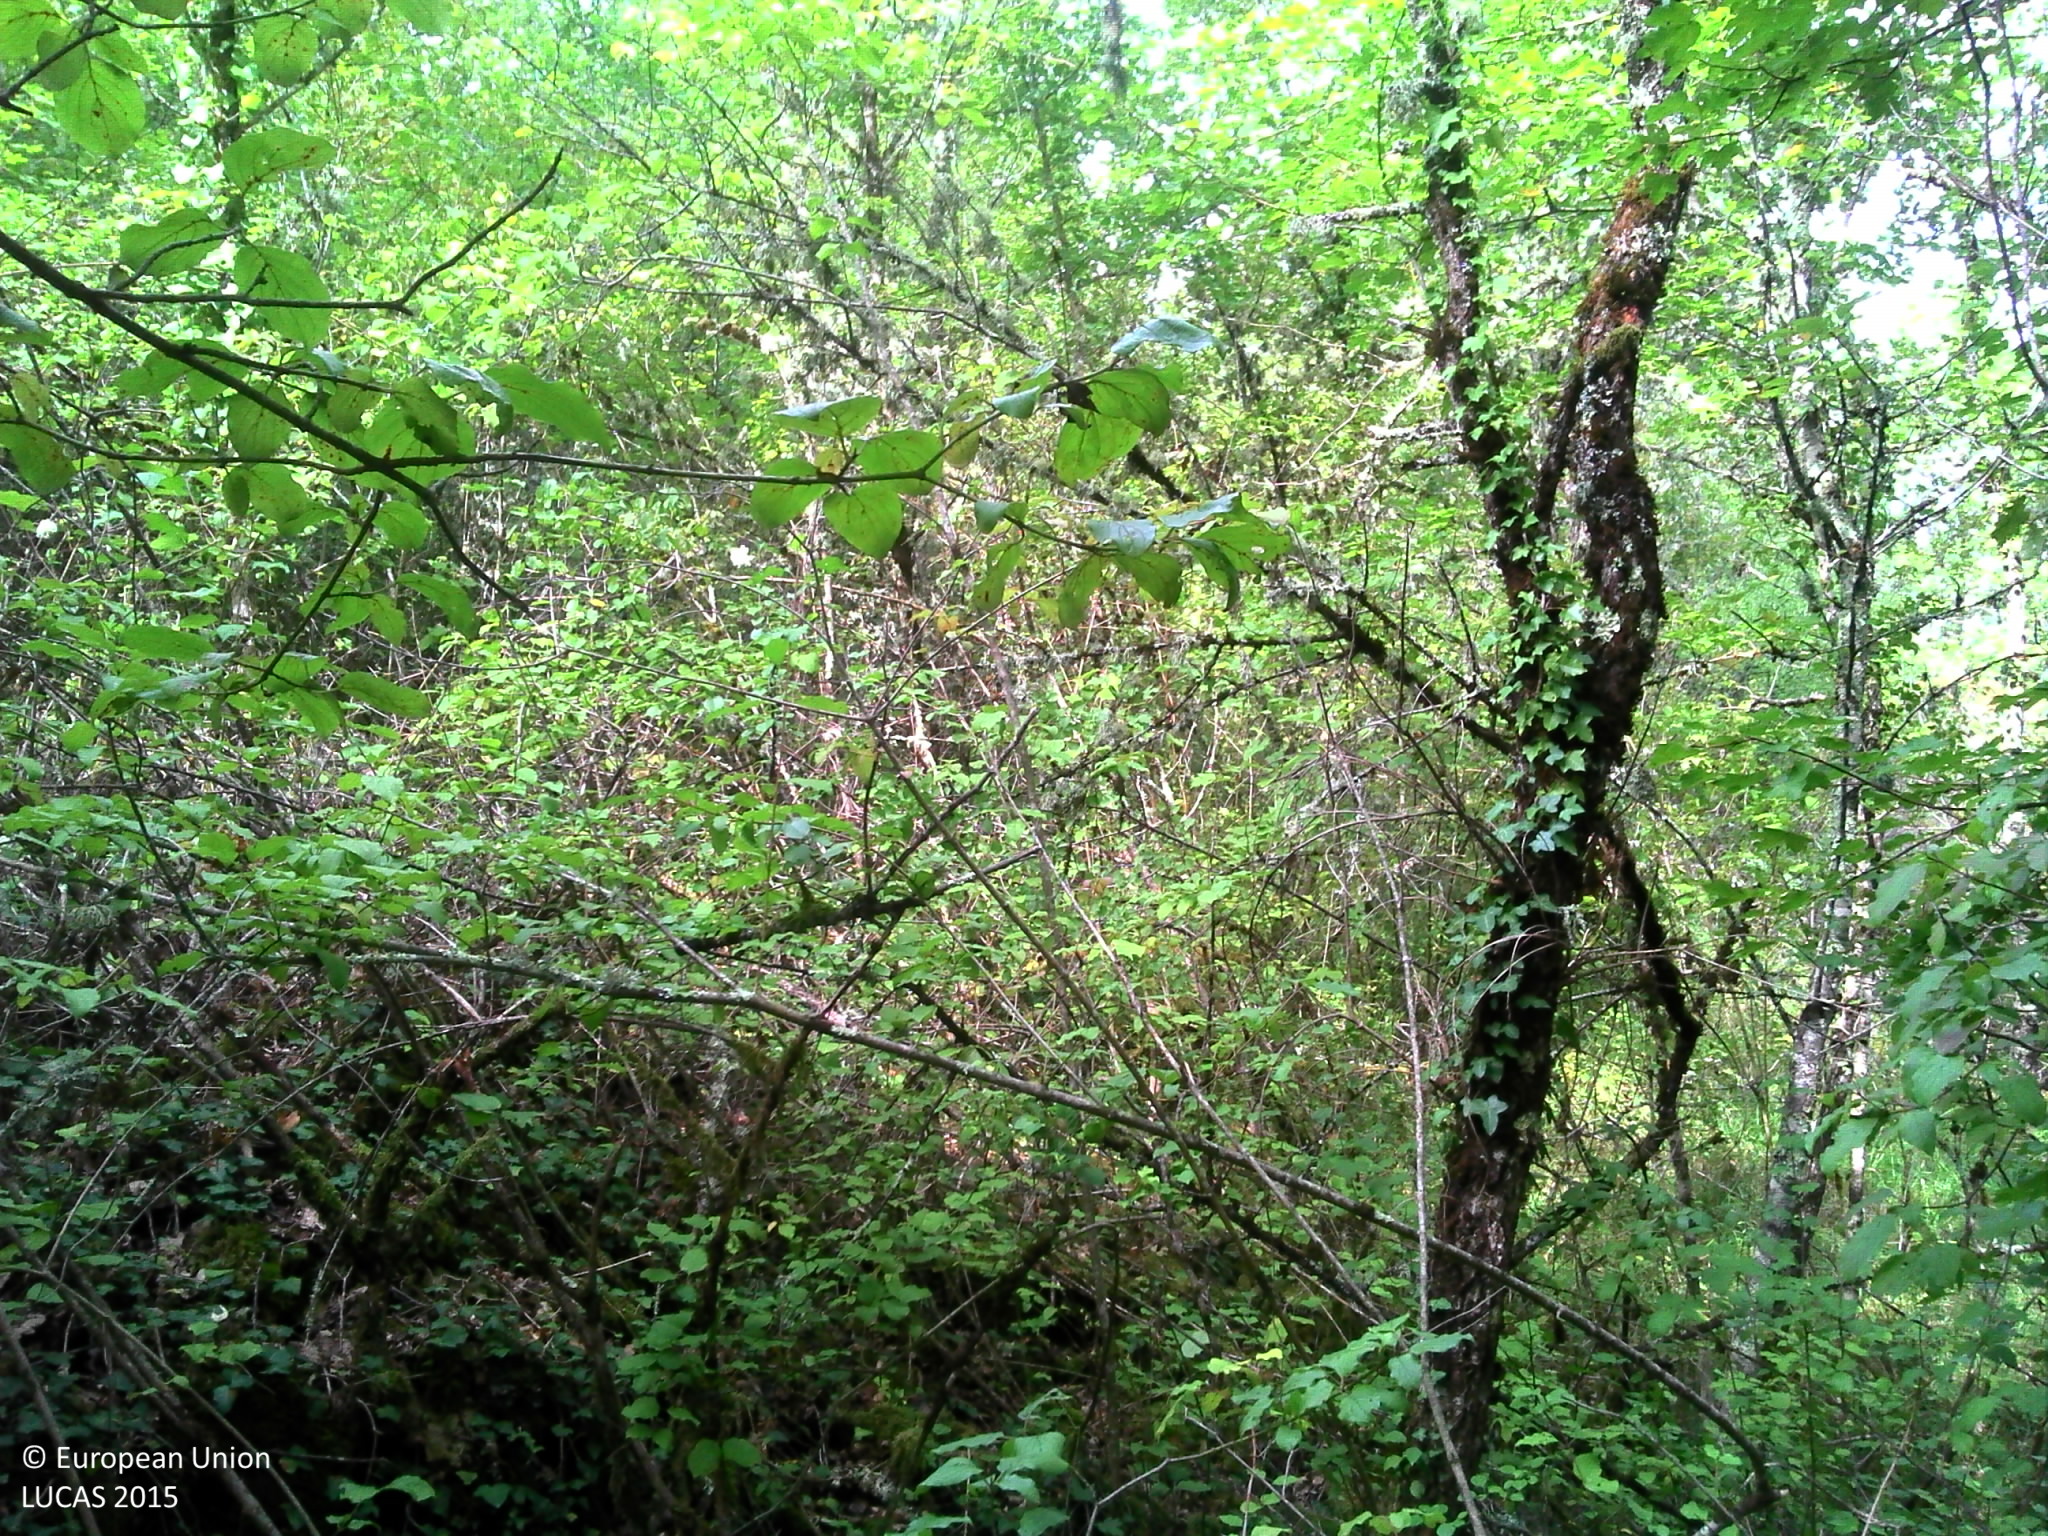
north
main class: Woodland
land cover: Broadleaved woodland
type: thermophilous deciduous forest
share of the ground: > 75 %
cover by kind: broadleaved forest trees 60 %, shrubs 30 %, herbaceous plants 5 %, lichens and mosses 5 %
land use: Agriculture (excluding fallow land and kitchen gardens)
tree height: > 5 m
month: September
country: FR
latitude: 44.5803
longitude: 1.2688
